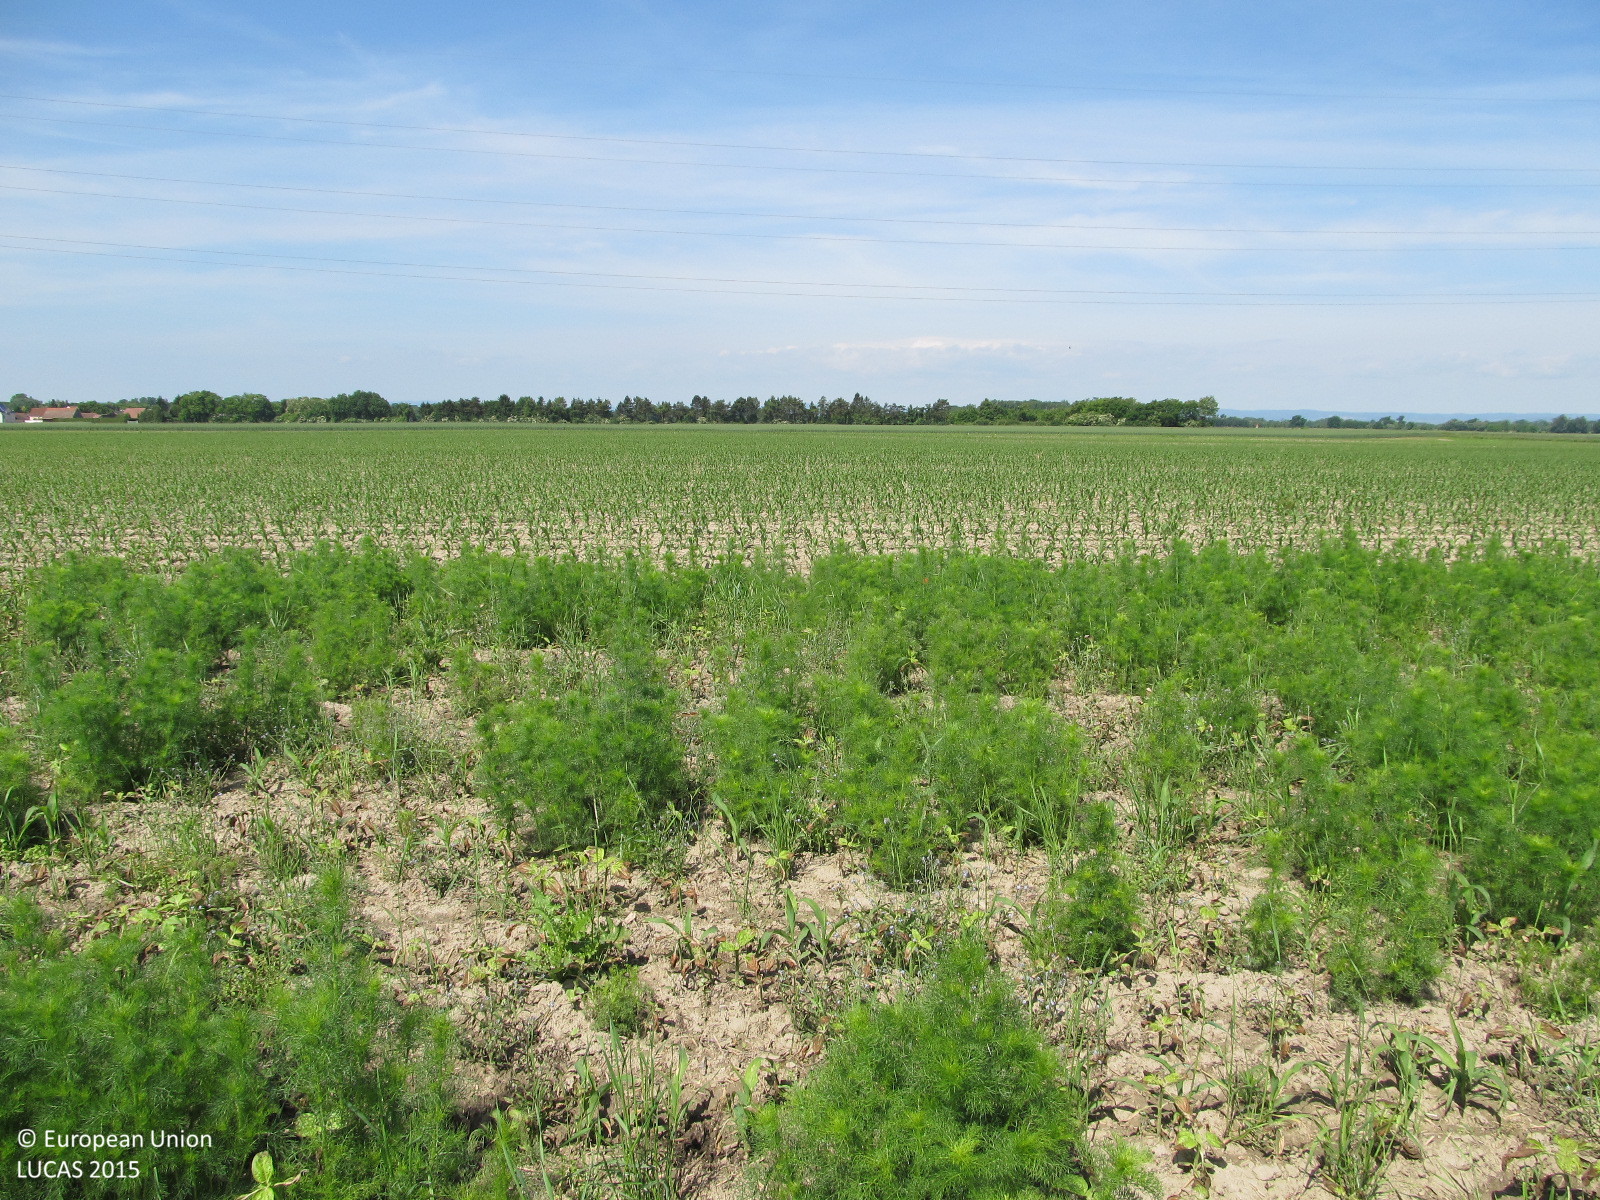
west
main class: Cropland
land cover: Maize
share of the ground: < 10 %
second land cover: Spontaneously vegetated surfaces
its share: > 75 %
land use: Agriculture (excluding fallow land and kitchen gardens)
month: May
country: AT
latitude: 48.3914
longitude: 15.8783
